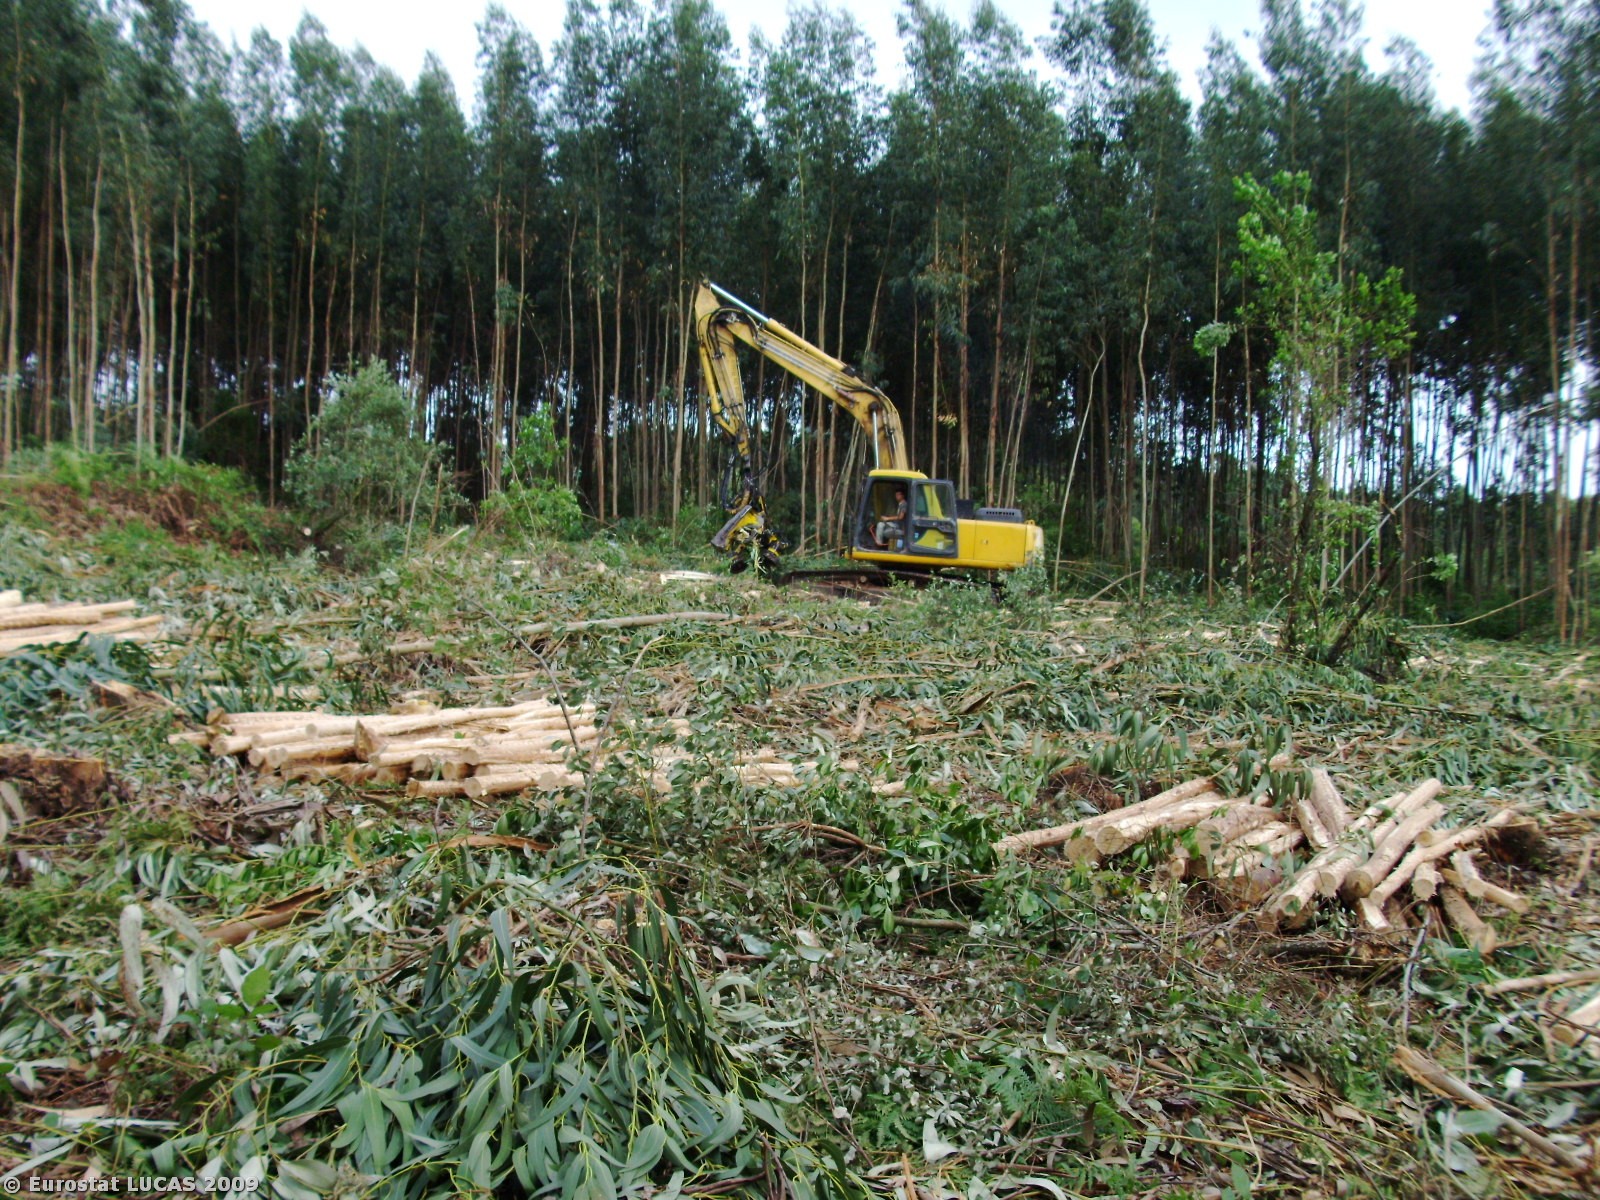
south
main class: Woodland
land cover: Broadleaved woodland
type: plantations and self-sown exotic forest
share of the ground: 10 - 25 %
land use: Forestry
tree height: > 5 m
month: June
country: PT
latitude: 39.7257
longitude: -8.3306
